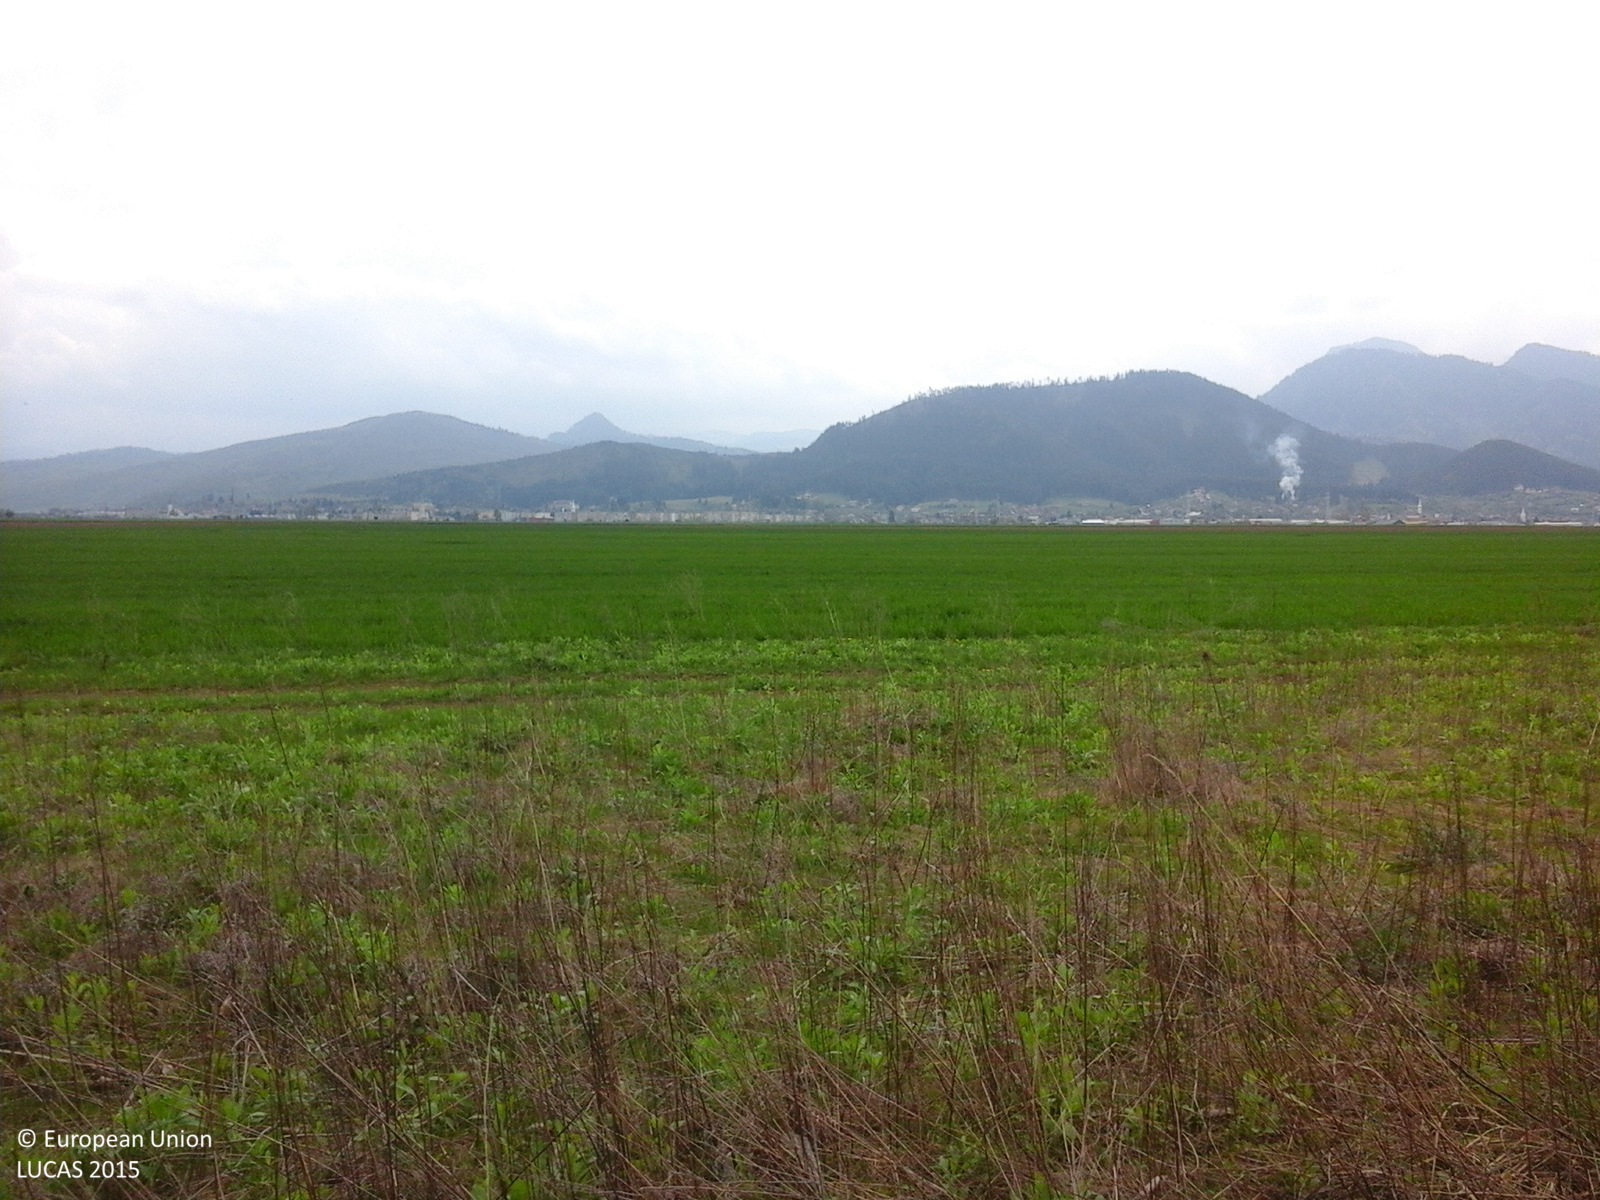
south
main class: Grassland
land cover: Grassland without tree/shrub cover
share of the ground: > 75 %
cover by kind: herbaceous plants 100 %
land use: Agriculture (excluding fallow land and kitchen gardens)
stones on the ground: 10 - 25 %
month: May
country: RO
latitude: 45.6380
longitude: 25.7201
